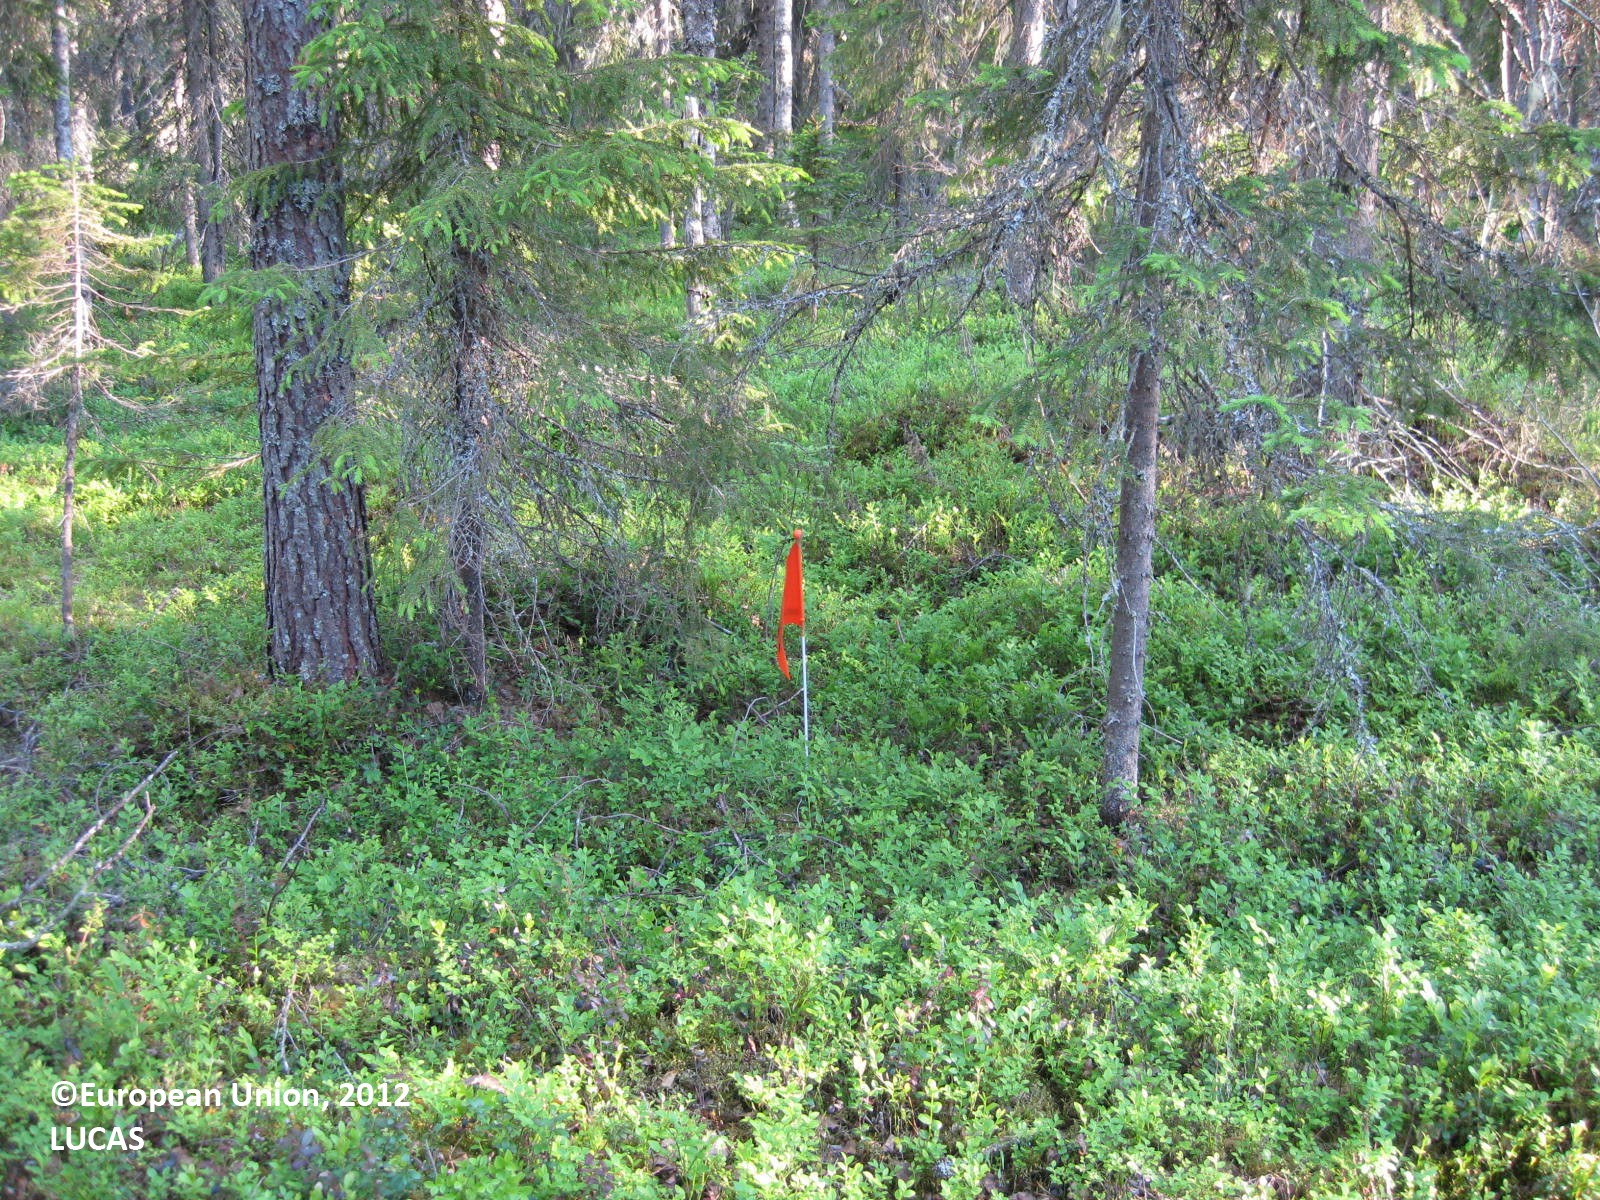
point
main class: Woodland
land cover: Spruce dominated coniferous woodland
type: boreal forest
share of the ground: > 75 %
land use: Forestry
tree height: > 5 m
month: June
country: FI
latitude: 65.2657
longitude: 28.2562
